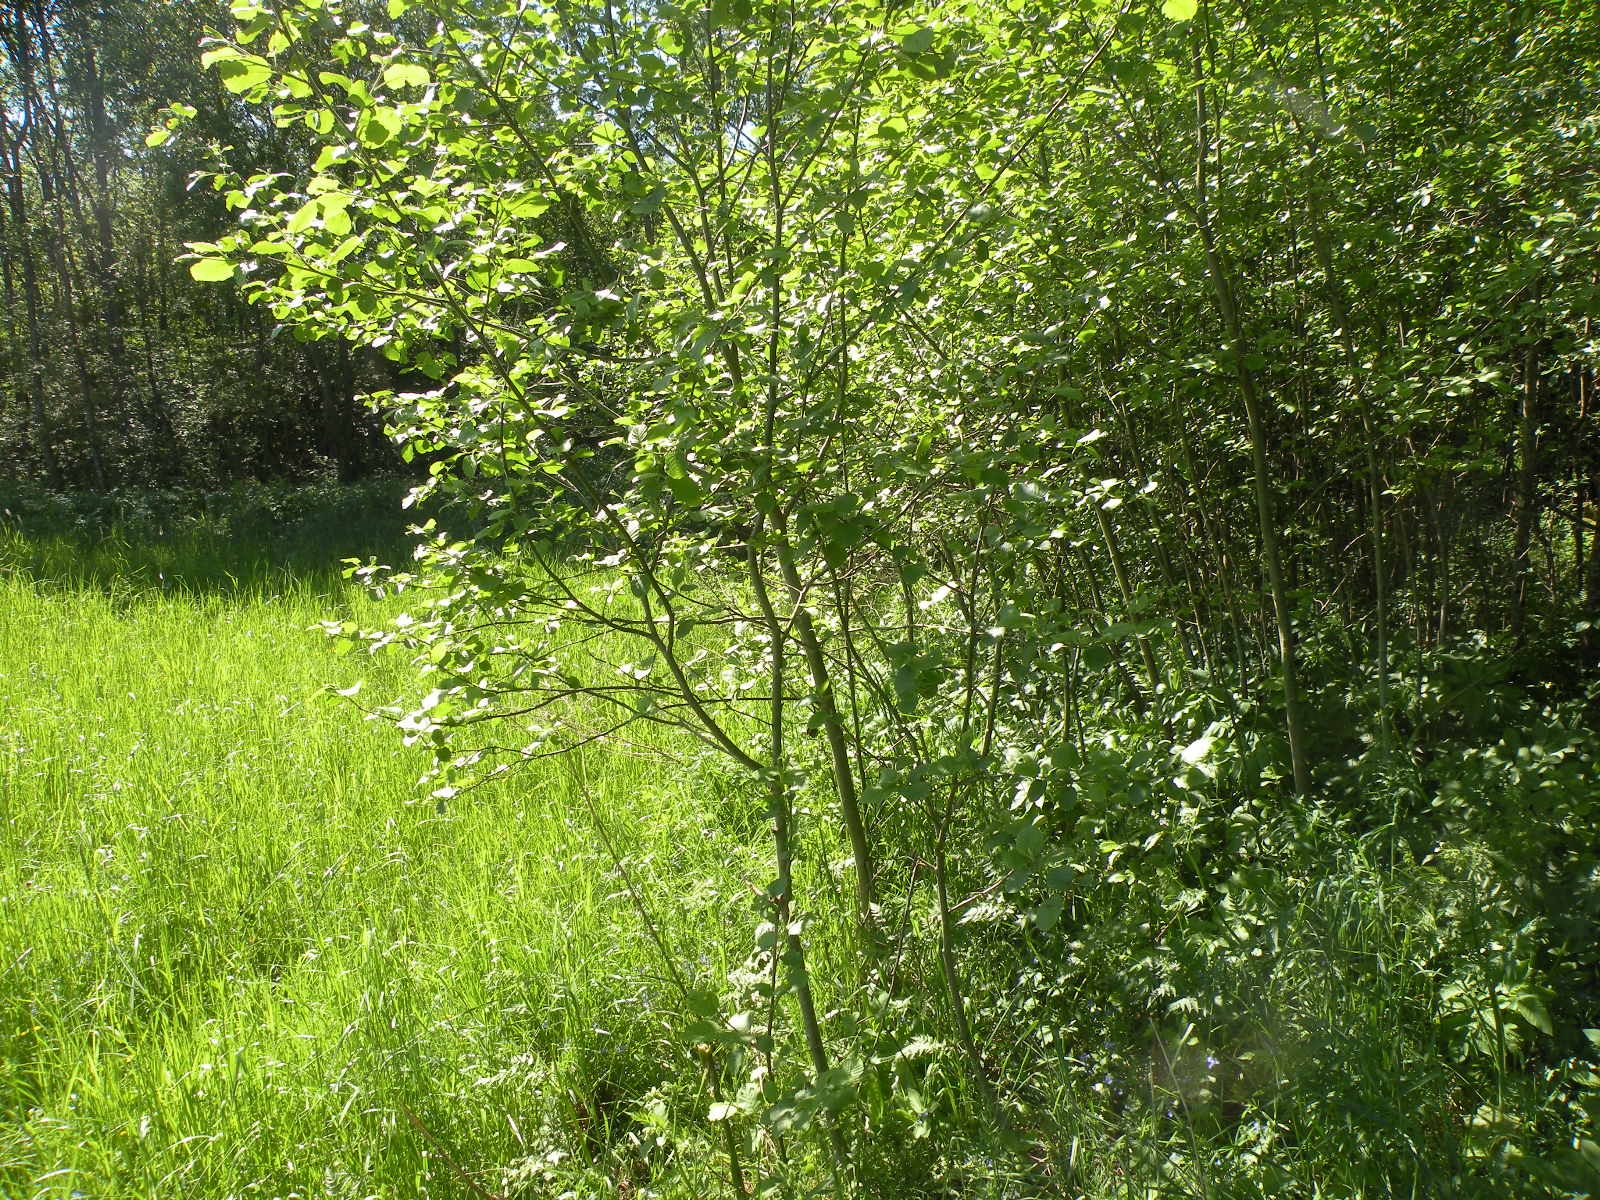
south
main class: Grassland
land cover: Grassland without tree/shrub cover
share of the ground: > 75 %
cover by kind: herbaceous plants 100 %
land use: Agriculture (excluding fallow land and kitchen gardens)
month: May
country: LV
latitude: 56.0259
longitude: 26.2360
